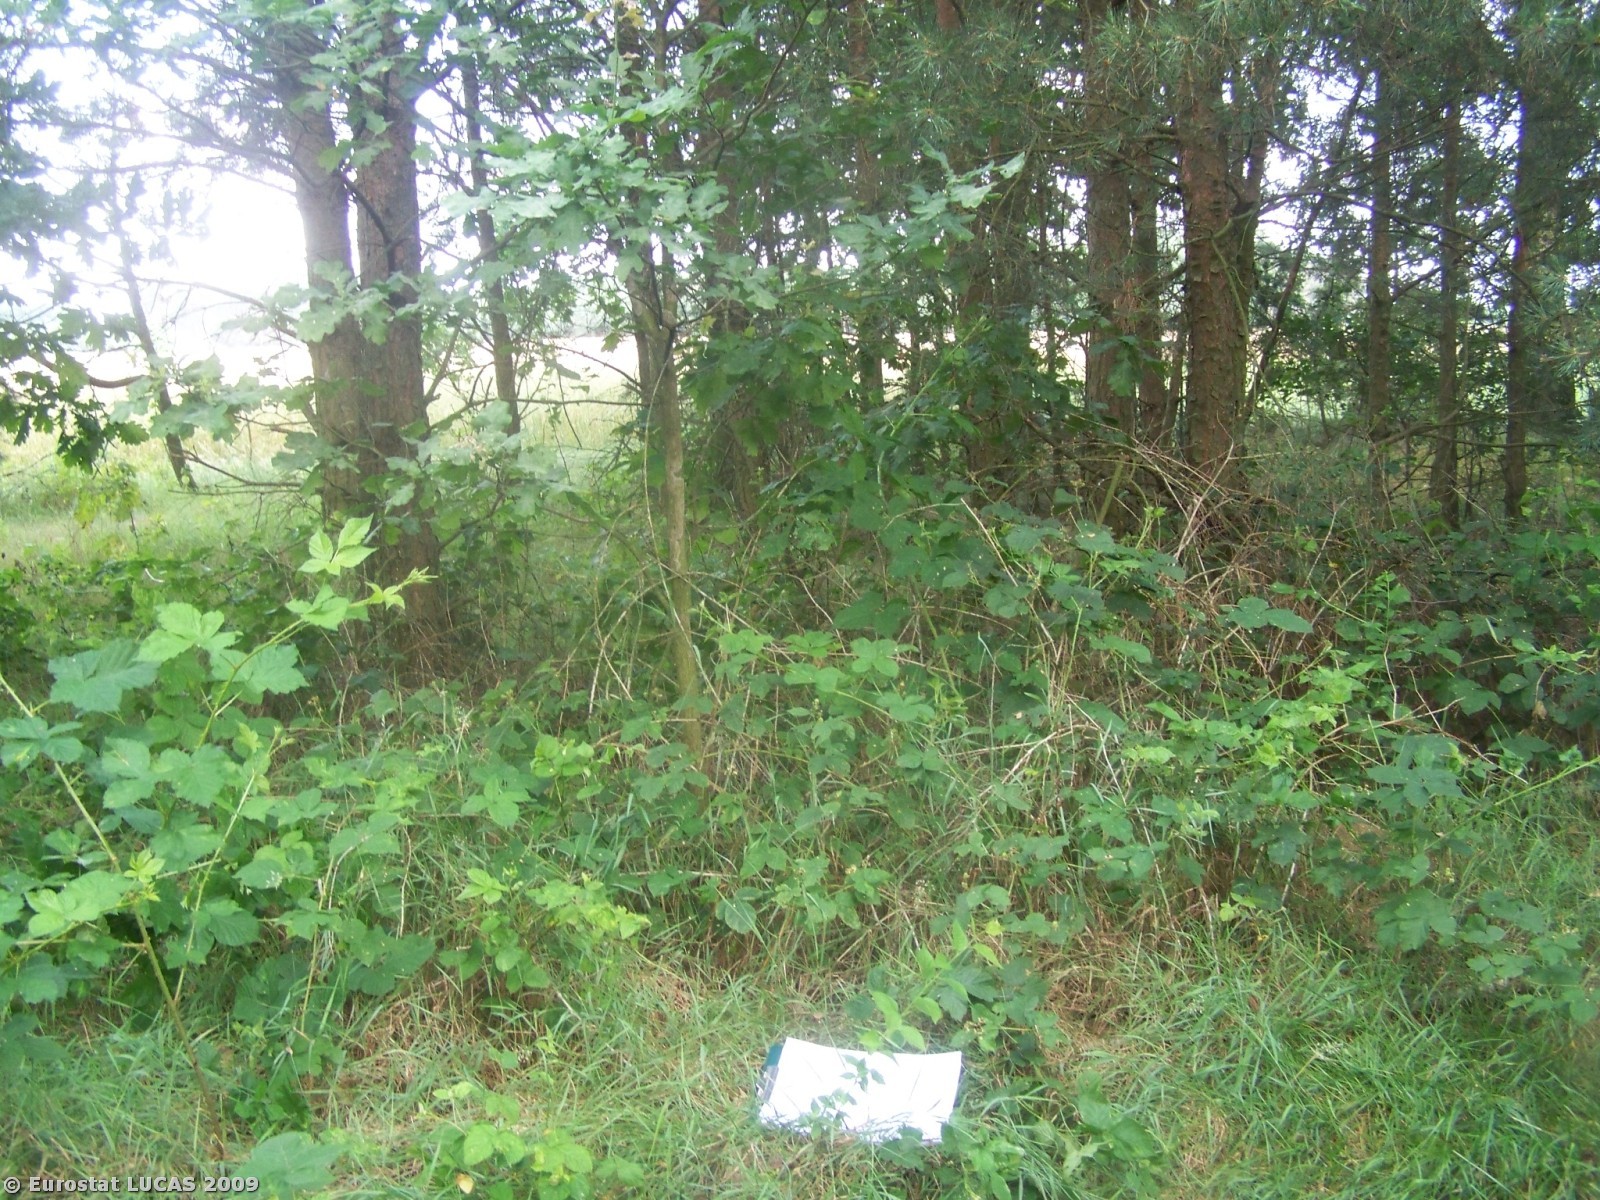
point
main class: Woodland
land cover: Coniferous woodland
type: hemiboreal forest and nemoral coniferous forest and mixed broadleaved-coniferous forest
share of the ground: > 75 %
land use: Forestry
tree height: > 5 m
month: July
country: PL
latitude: 52.0236
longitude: 21.6095
